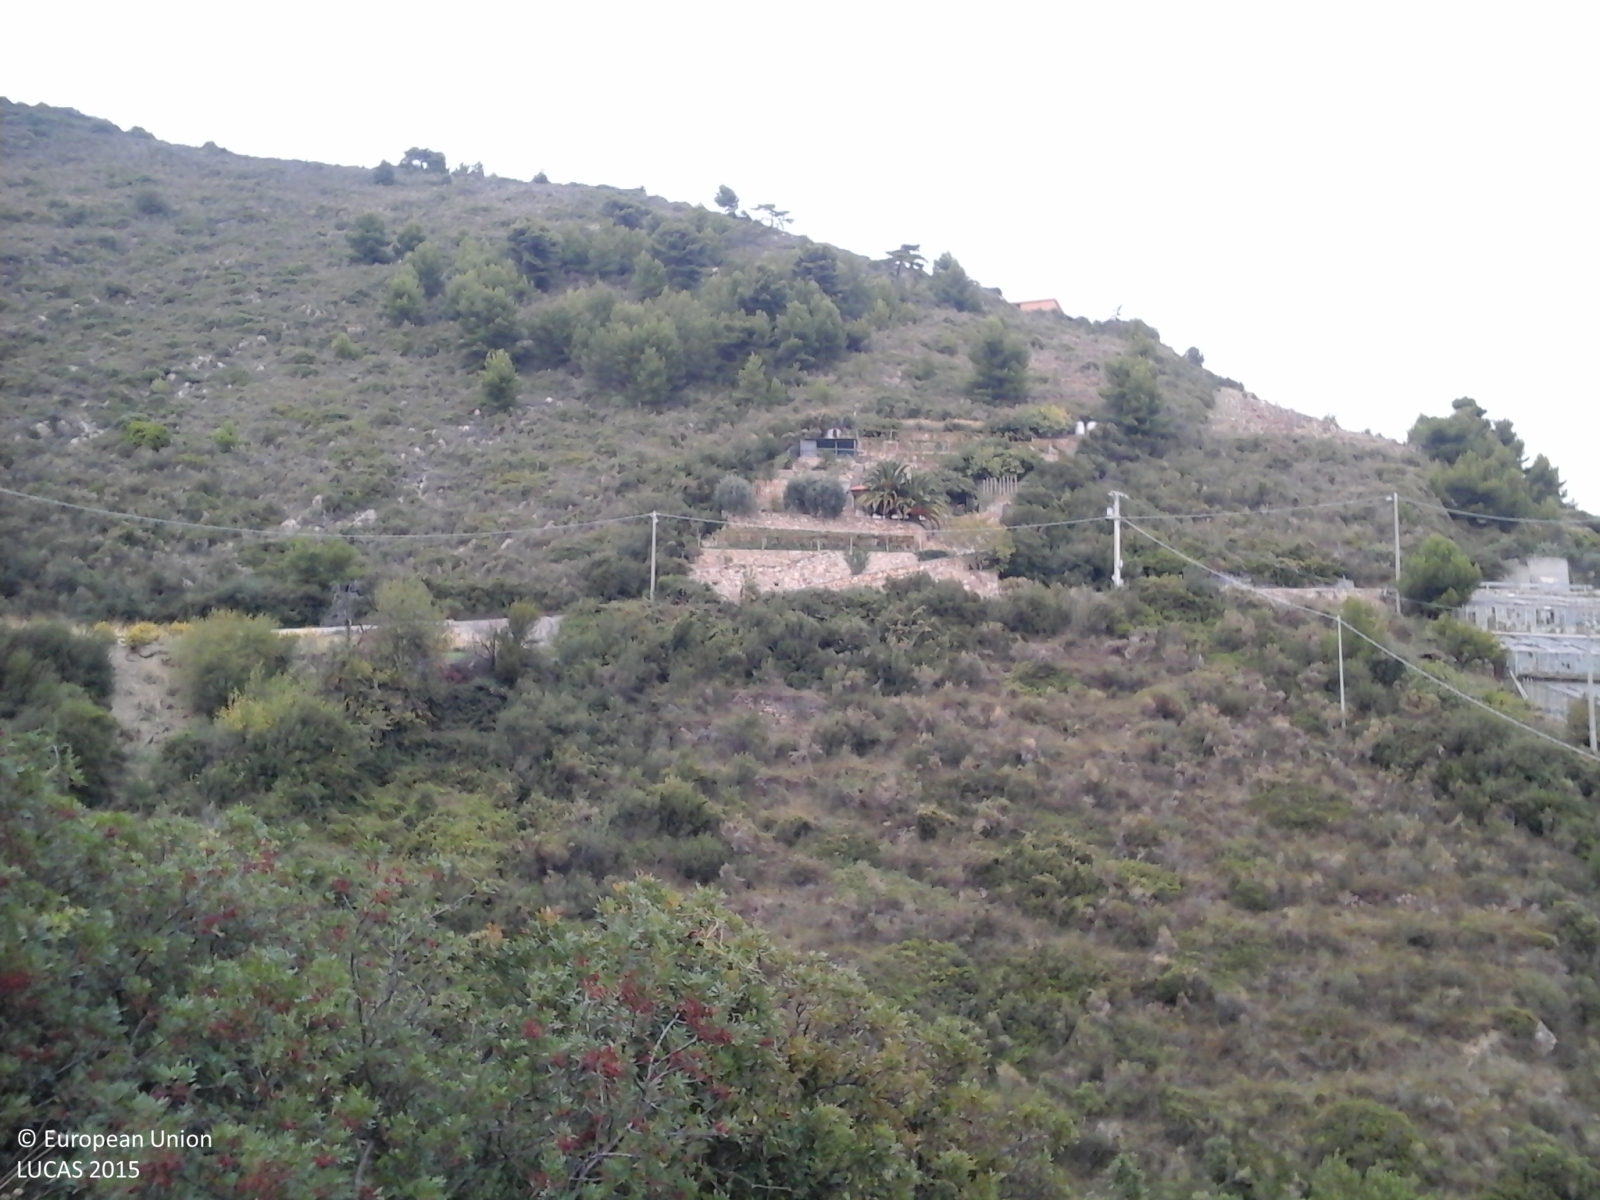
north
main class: Shrubland
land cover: Shrubland with sparse tree cover
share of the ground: > 75 %
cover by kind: shrubs 60 %, herbaceous plants 30 %, broadleaved forest trees 5 %, consolidated bare surface 5 %
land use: Semi-natural and natural areas not in use
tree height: > 5 m
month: October
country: IT
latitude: 43.8205
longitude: 7.7303
